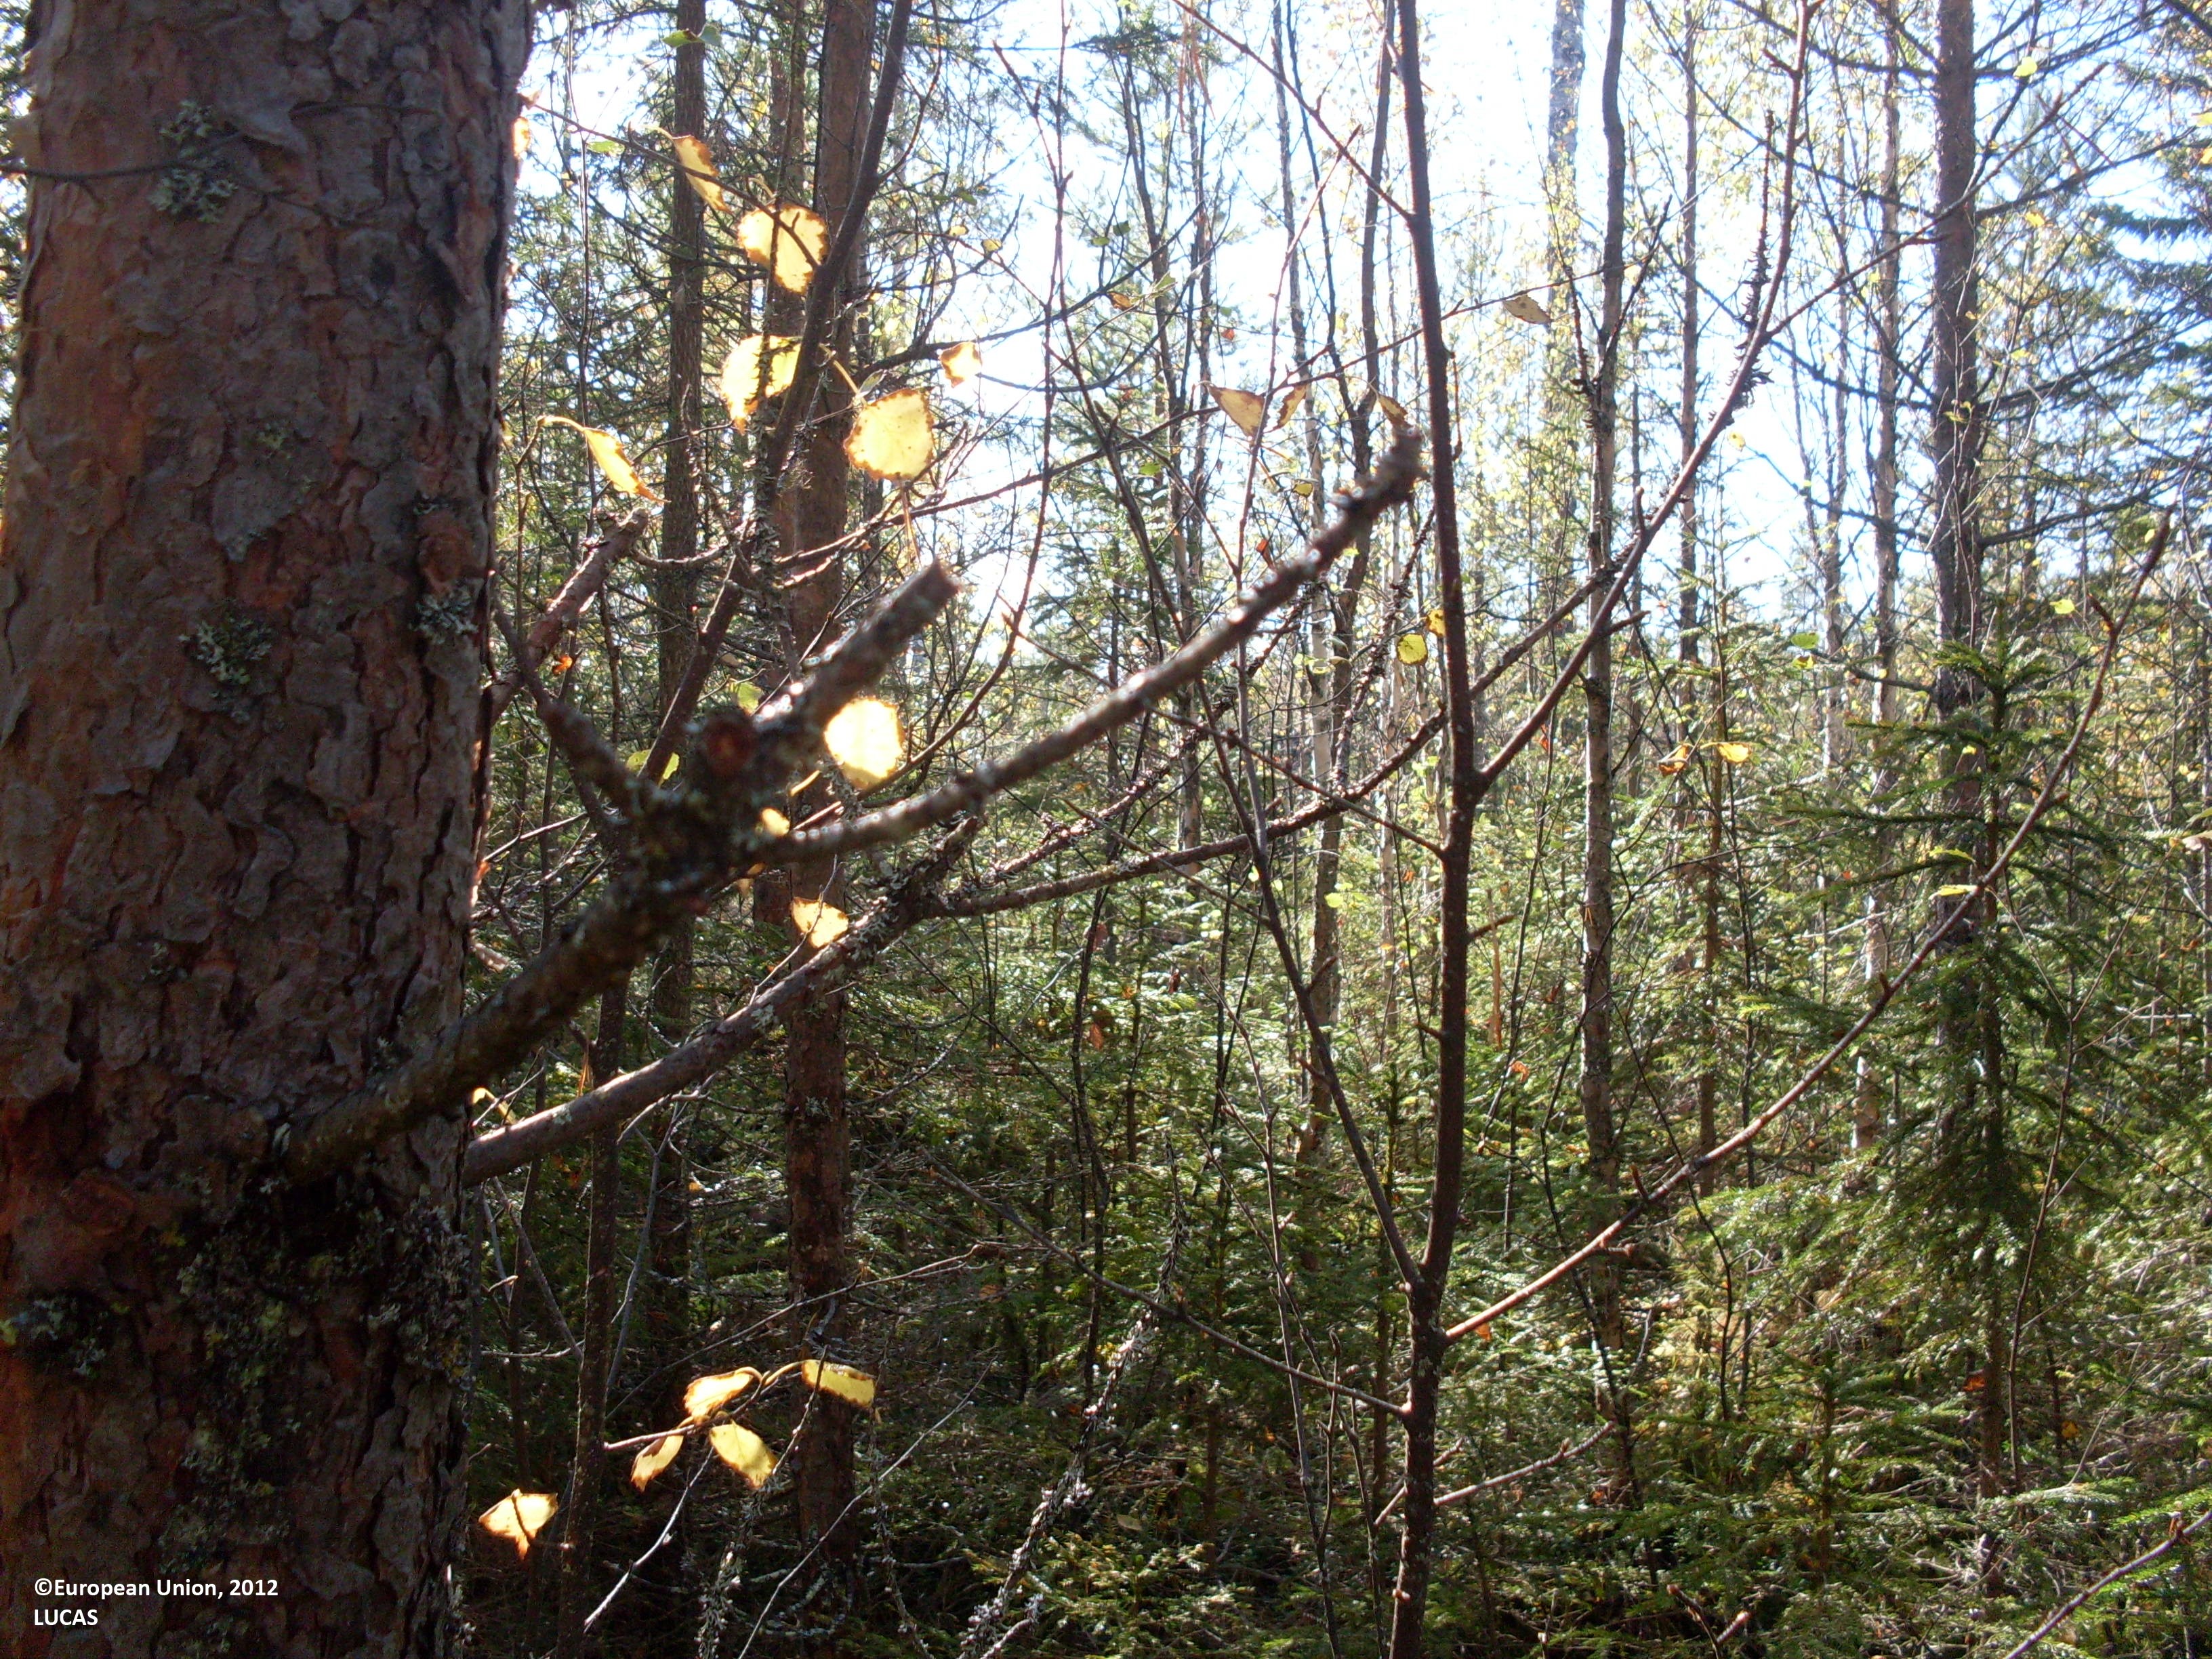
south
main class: Woodland
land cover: Pine dominated mixed woodland
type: boreal forest
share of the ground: > 75 %
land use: Forestry
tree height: > 5 m
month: September
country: FI
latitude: 64.3310
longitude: 28.5752
